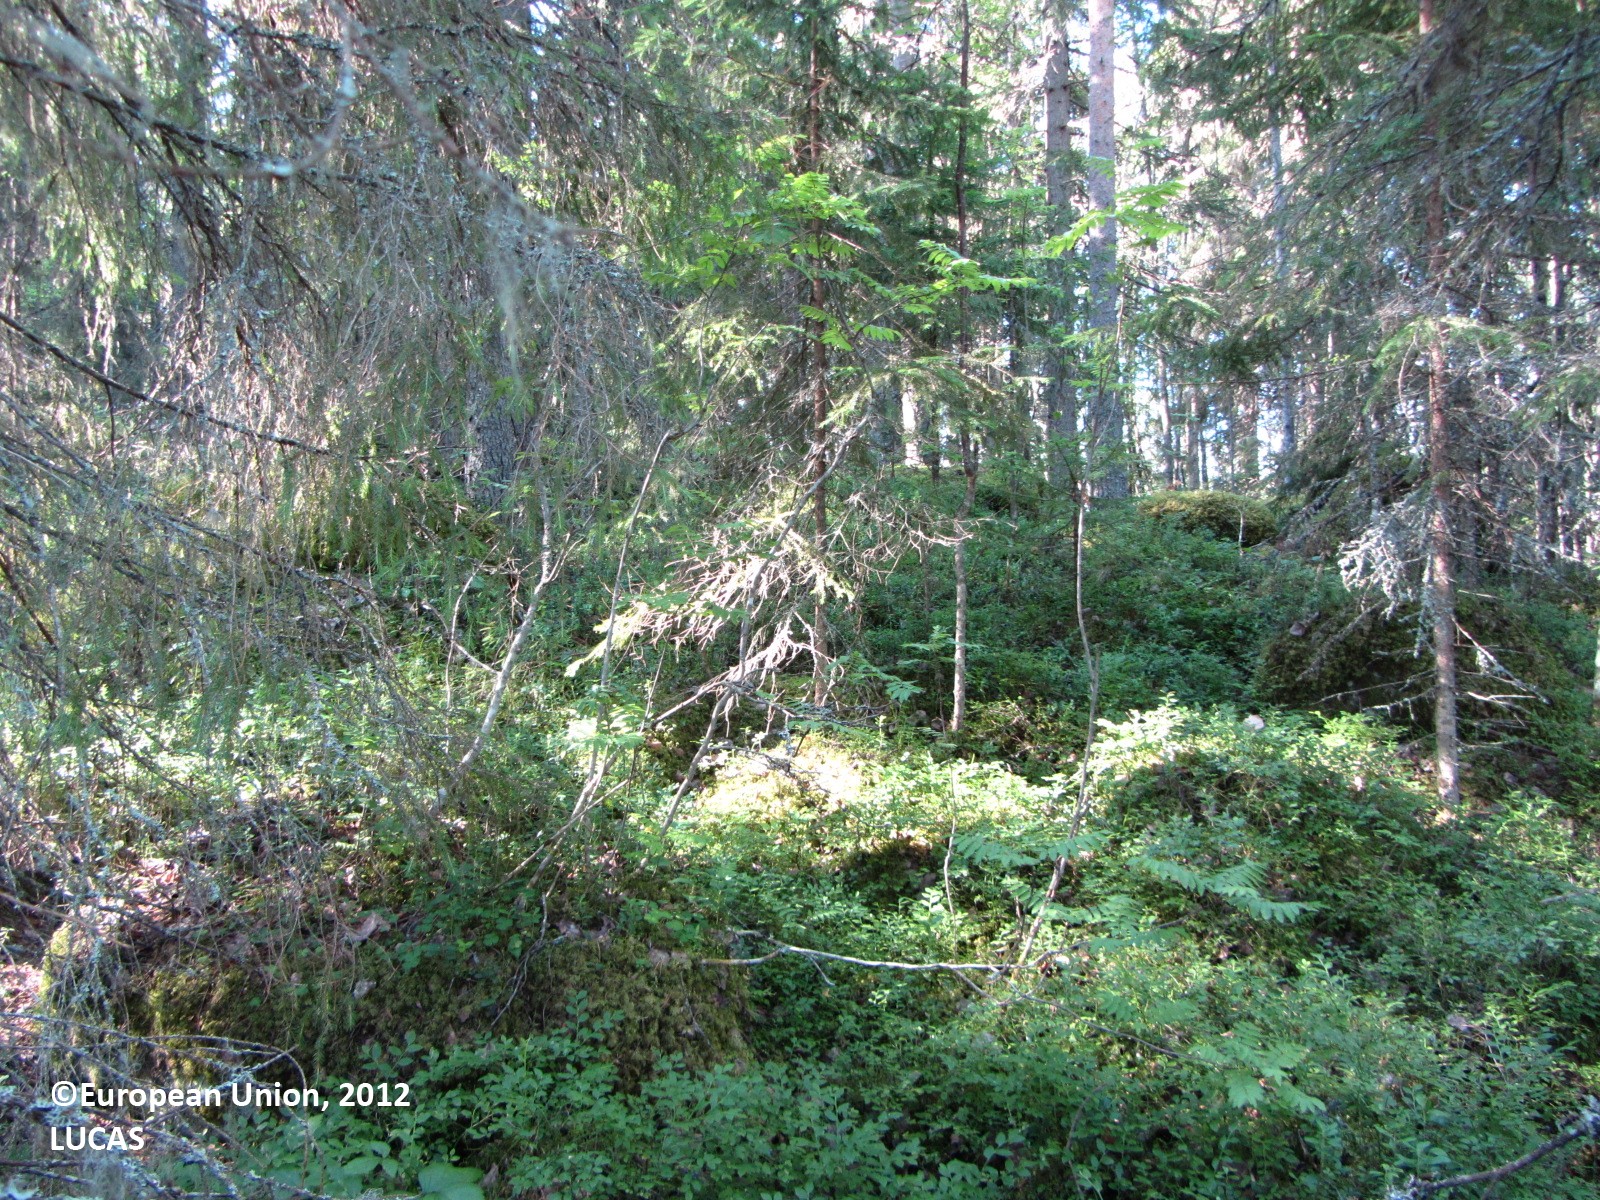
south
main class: Woodland
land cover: Other coniferous woodland
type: boreal forest
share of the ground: > 75 %
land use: Forestry
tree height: > 5 m
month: July
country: FI
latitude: 63.6722
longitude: 24.6935
